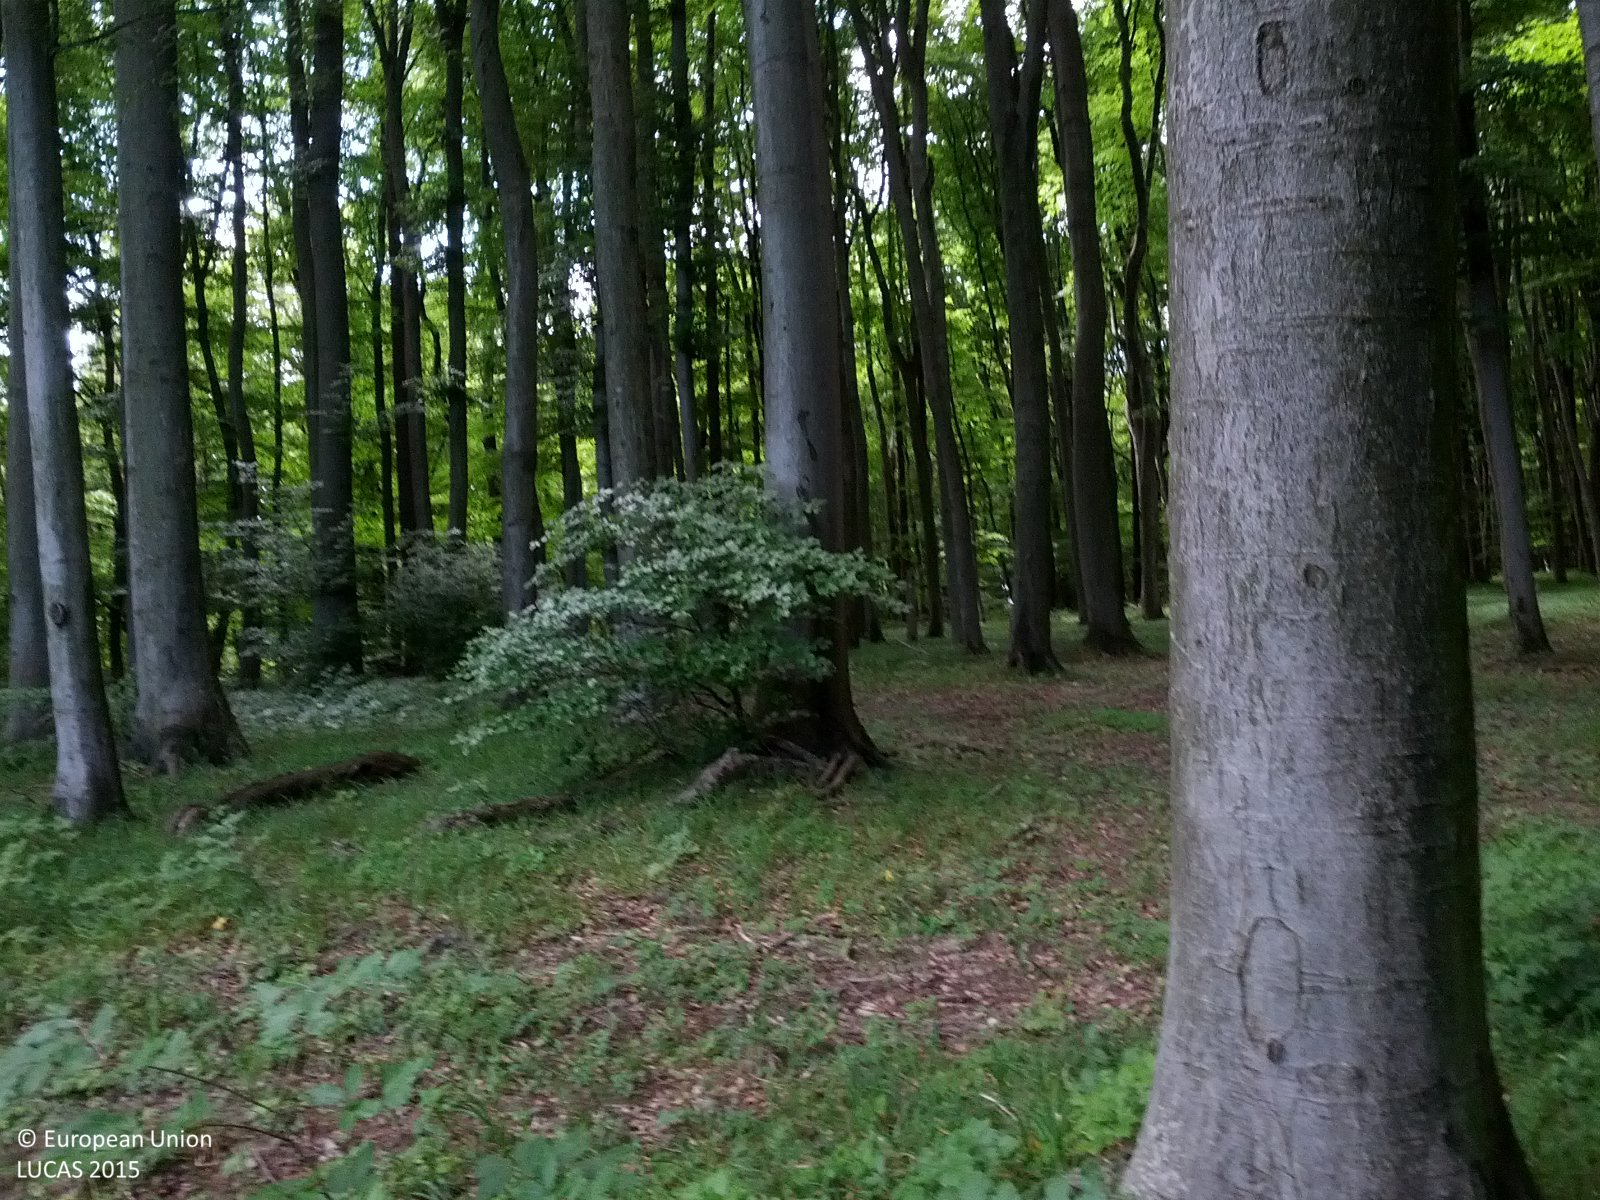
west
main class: Woodland
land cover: Broadleaved woodland
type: beech forest
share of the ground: > 75 %
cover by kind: broadleaved forest trees 80 %, herbaceous plants 15 %, shrubs 5 %
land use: Forestry
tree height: > 5 m
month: June
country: AT
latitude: 48.2528
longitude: 16.1053
